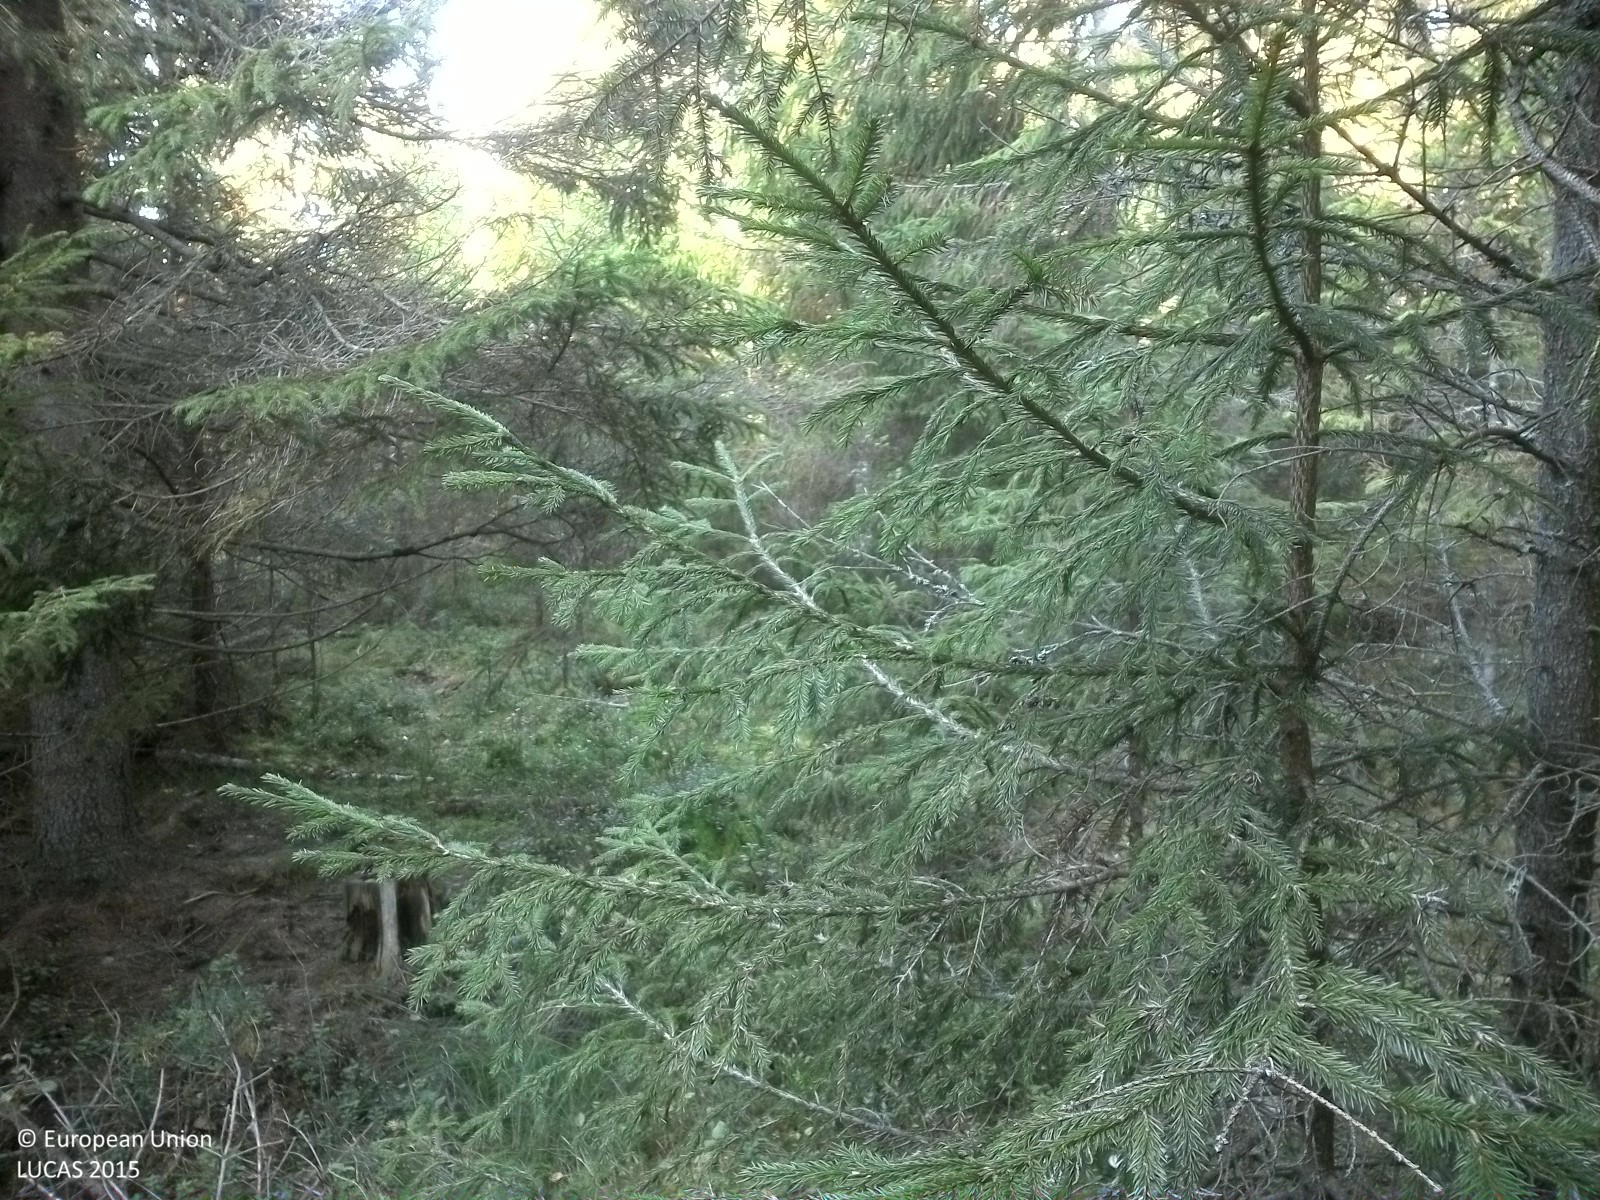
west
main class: Woodland
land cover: Spruce dominated coniferous woodland
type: boreal forest
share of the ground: 50 - 75 %
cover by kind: coniferous forest trees 50 %, herbaceous plants 20 %, broadleaved forest trees 10 %, lichens and mosses 10 %, unconsolidated bare surface 10 %
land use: Forestry
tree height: < 5 m
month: September
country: SE
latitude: 59.0593
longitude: 15.5900
